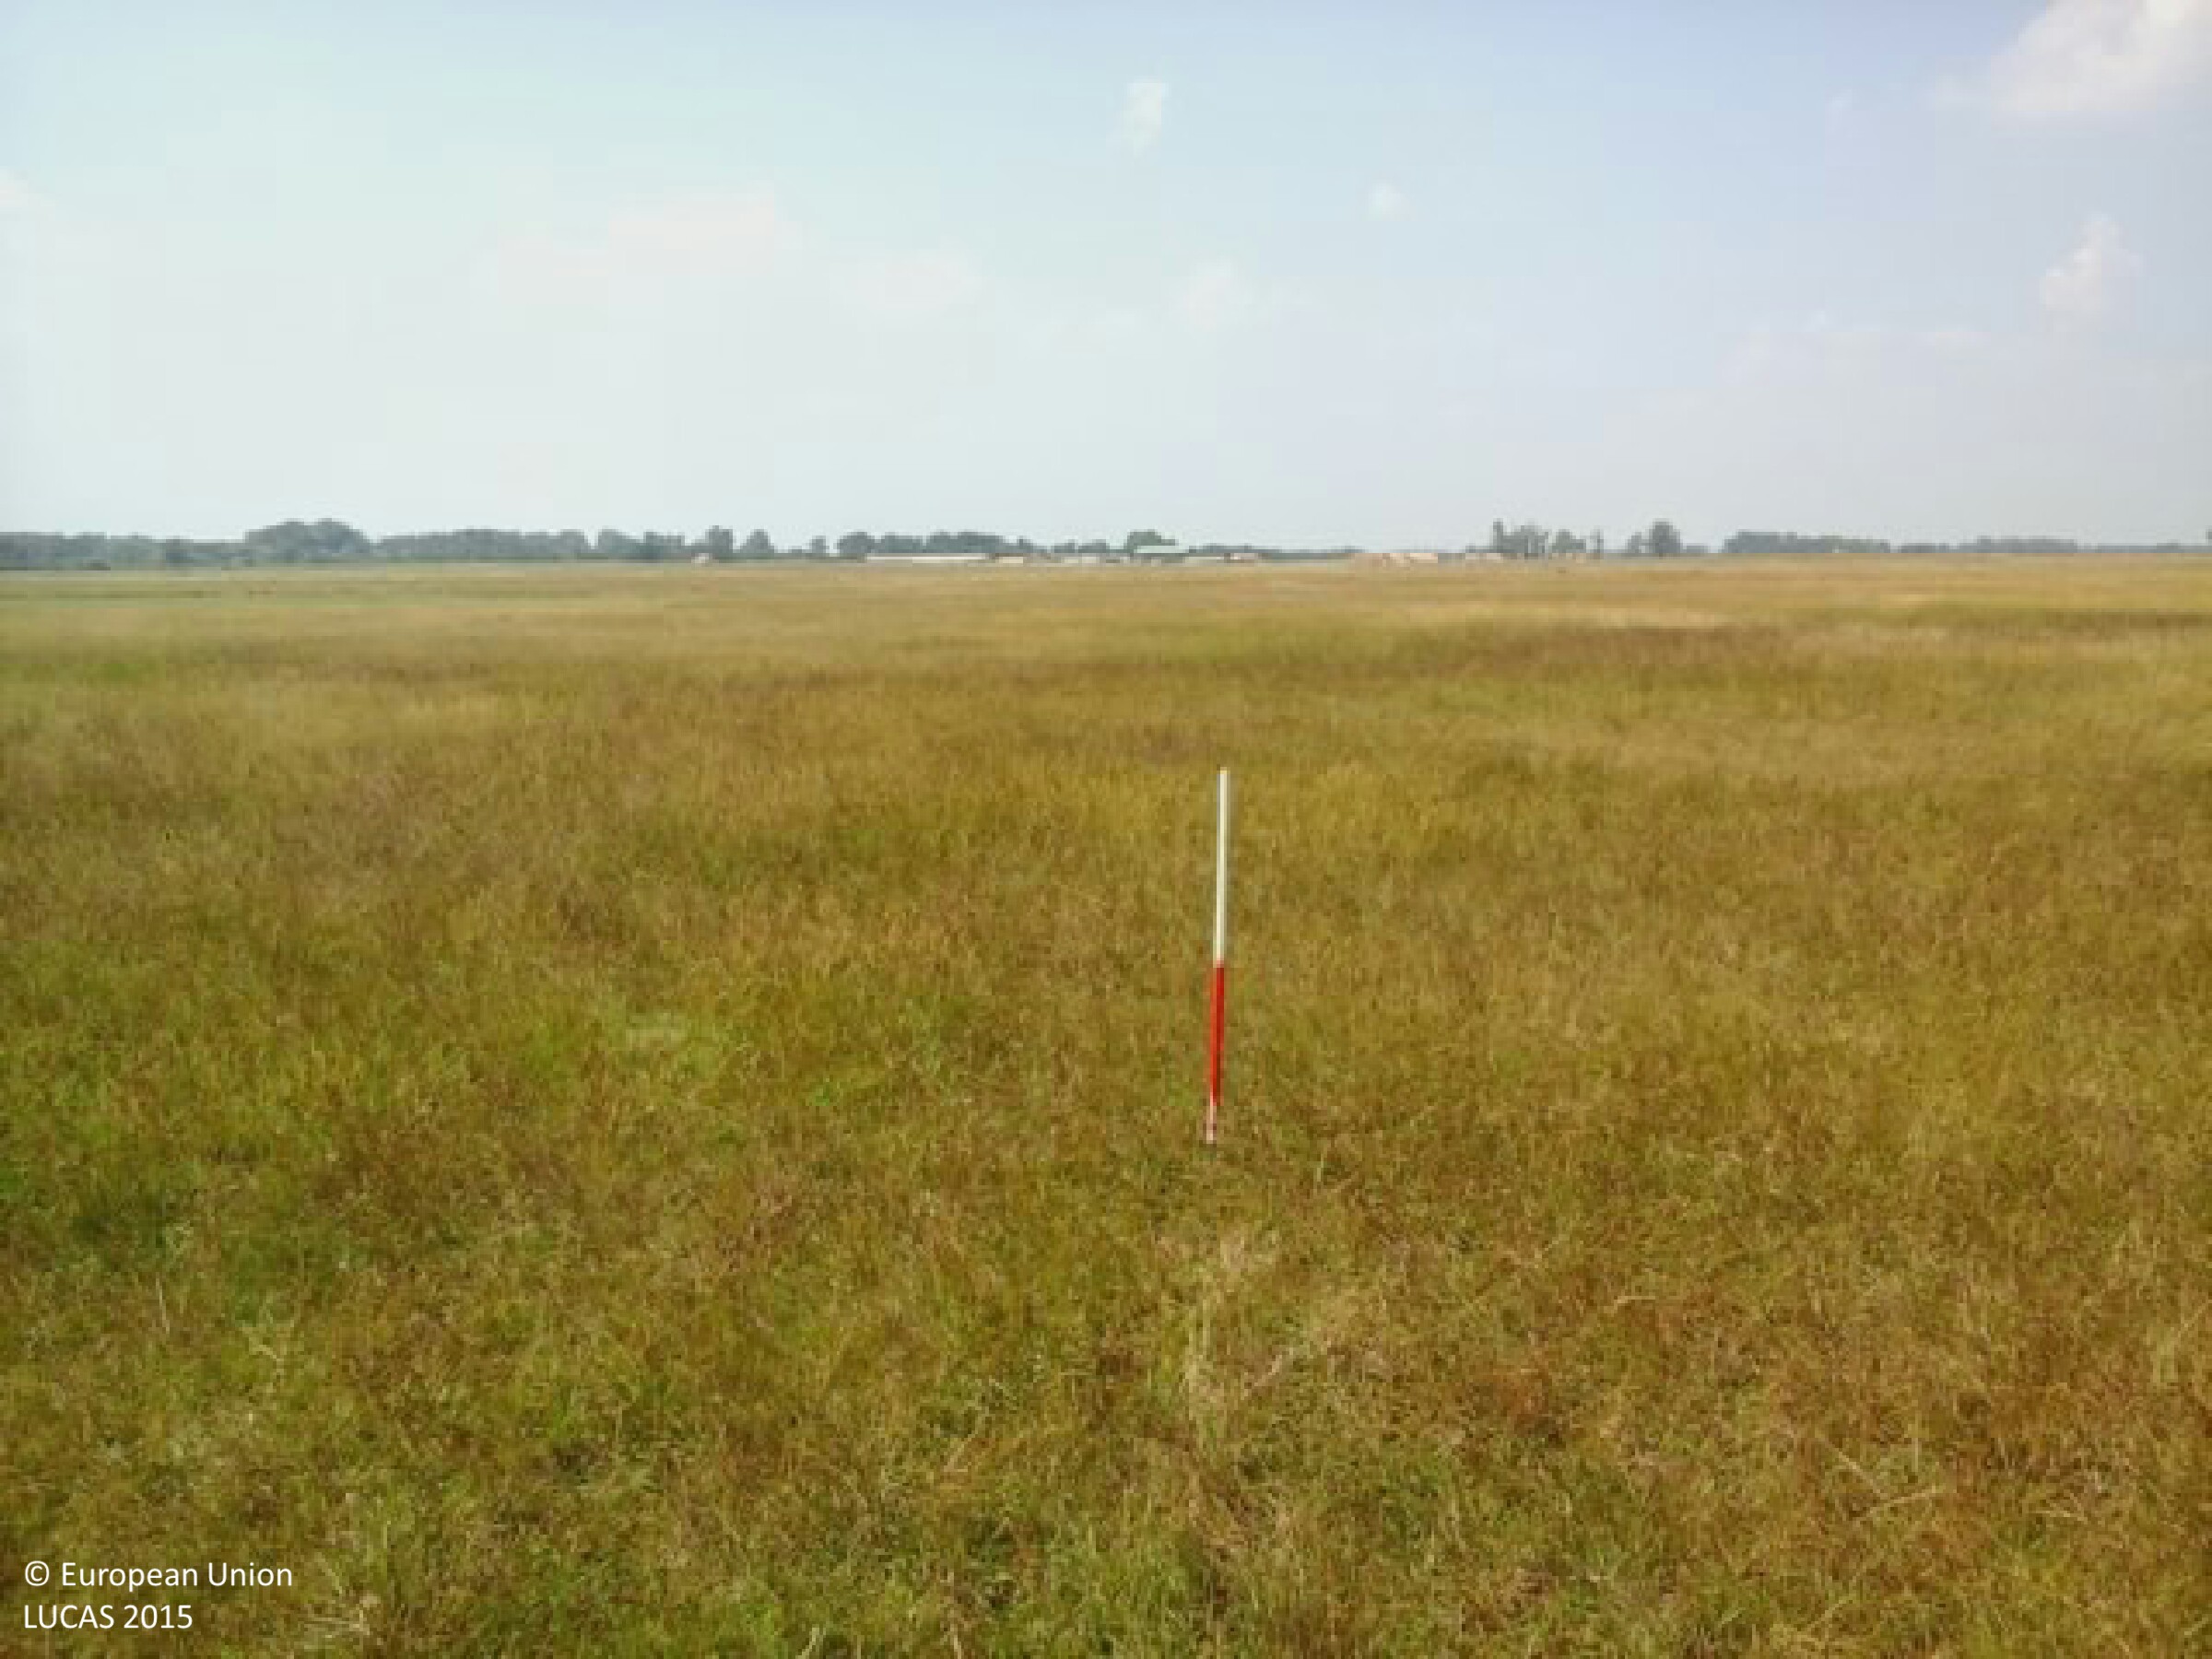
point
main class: Grassland
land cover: Grassland without tree/shrub cover
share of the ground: > 75 %
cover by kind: herbaceous plants 100 %
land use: Agriculture (excluding fallow land and kitchen gardens)
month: August
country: HU
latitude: 47.0709
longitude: 19.0631
